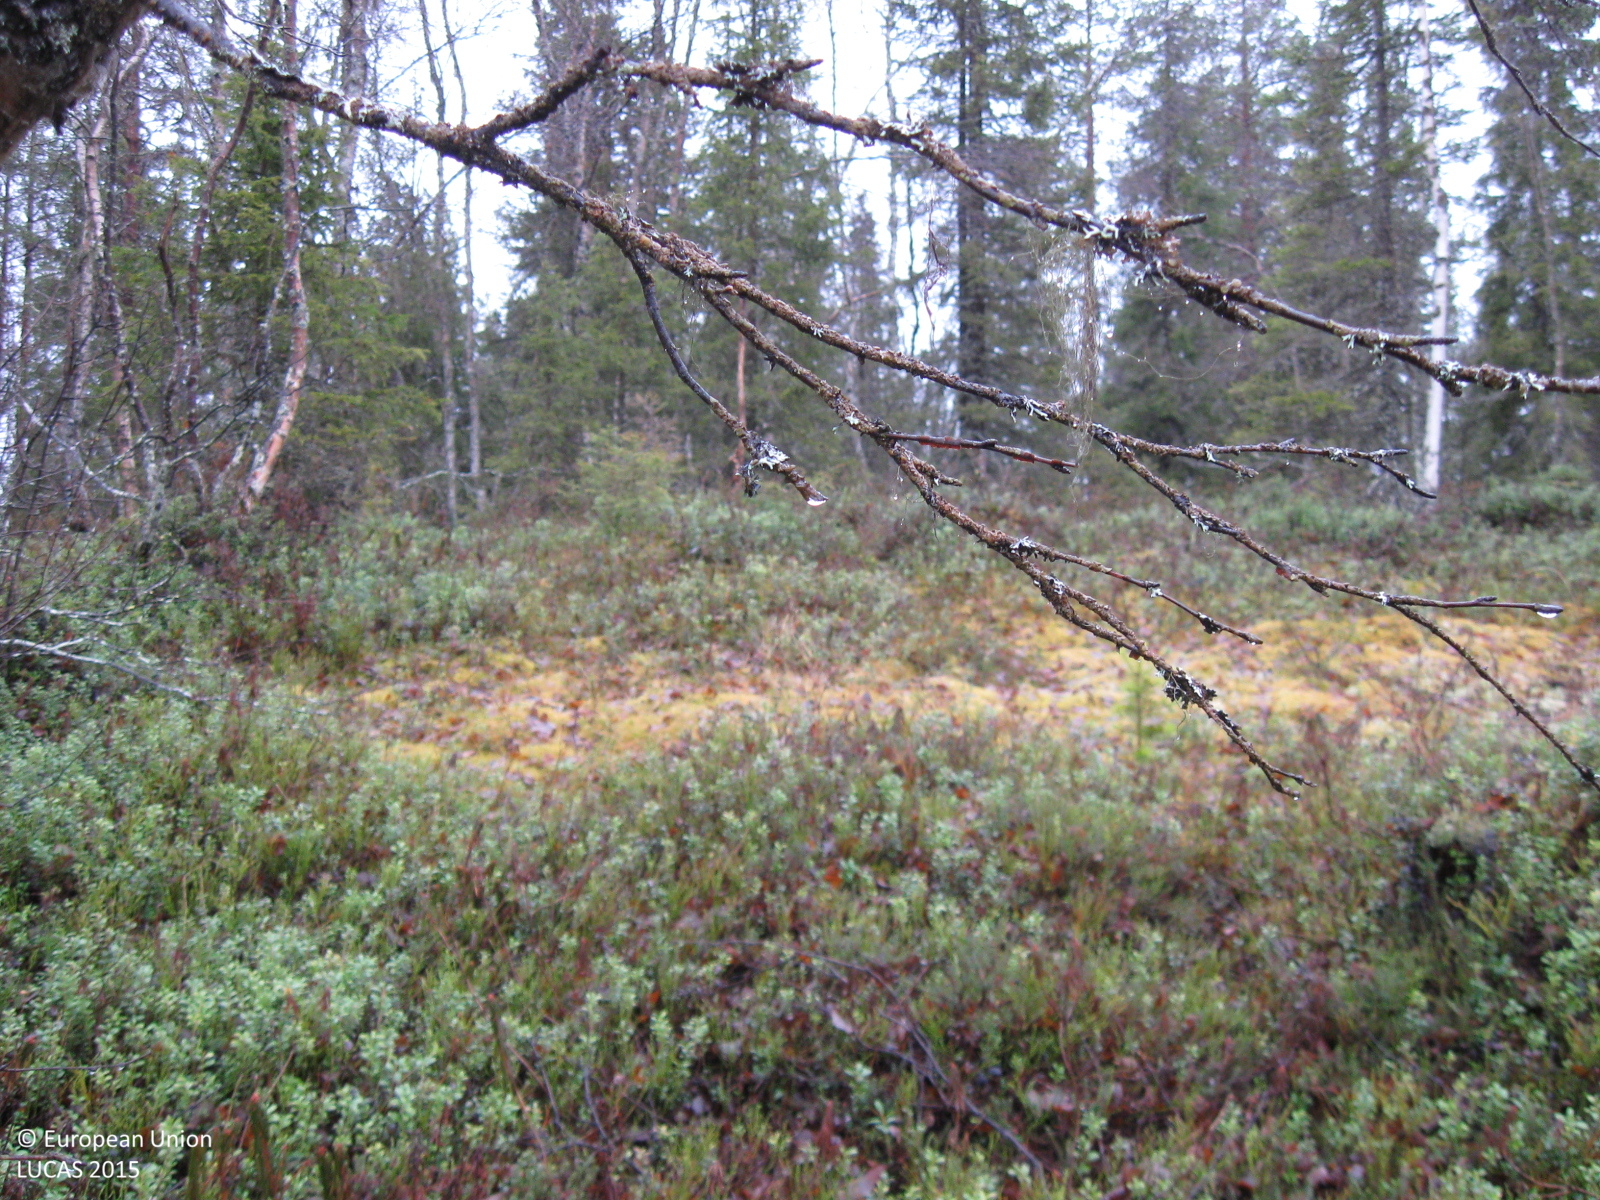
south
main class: Woodland
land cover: Spruce dominated mixed woodland
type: boreal forest
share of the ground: 50 - 75 %
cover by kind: shrubs 35 %, broadleaved forest trees 30 %, coniferous forest trees 20 %, herbaceous plants 10 %, lichens and mosses 5 %
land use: Forestry
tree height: > 5 m
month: October
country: SE
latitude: 66.5410
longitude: 20.9662
